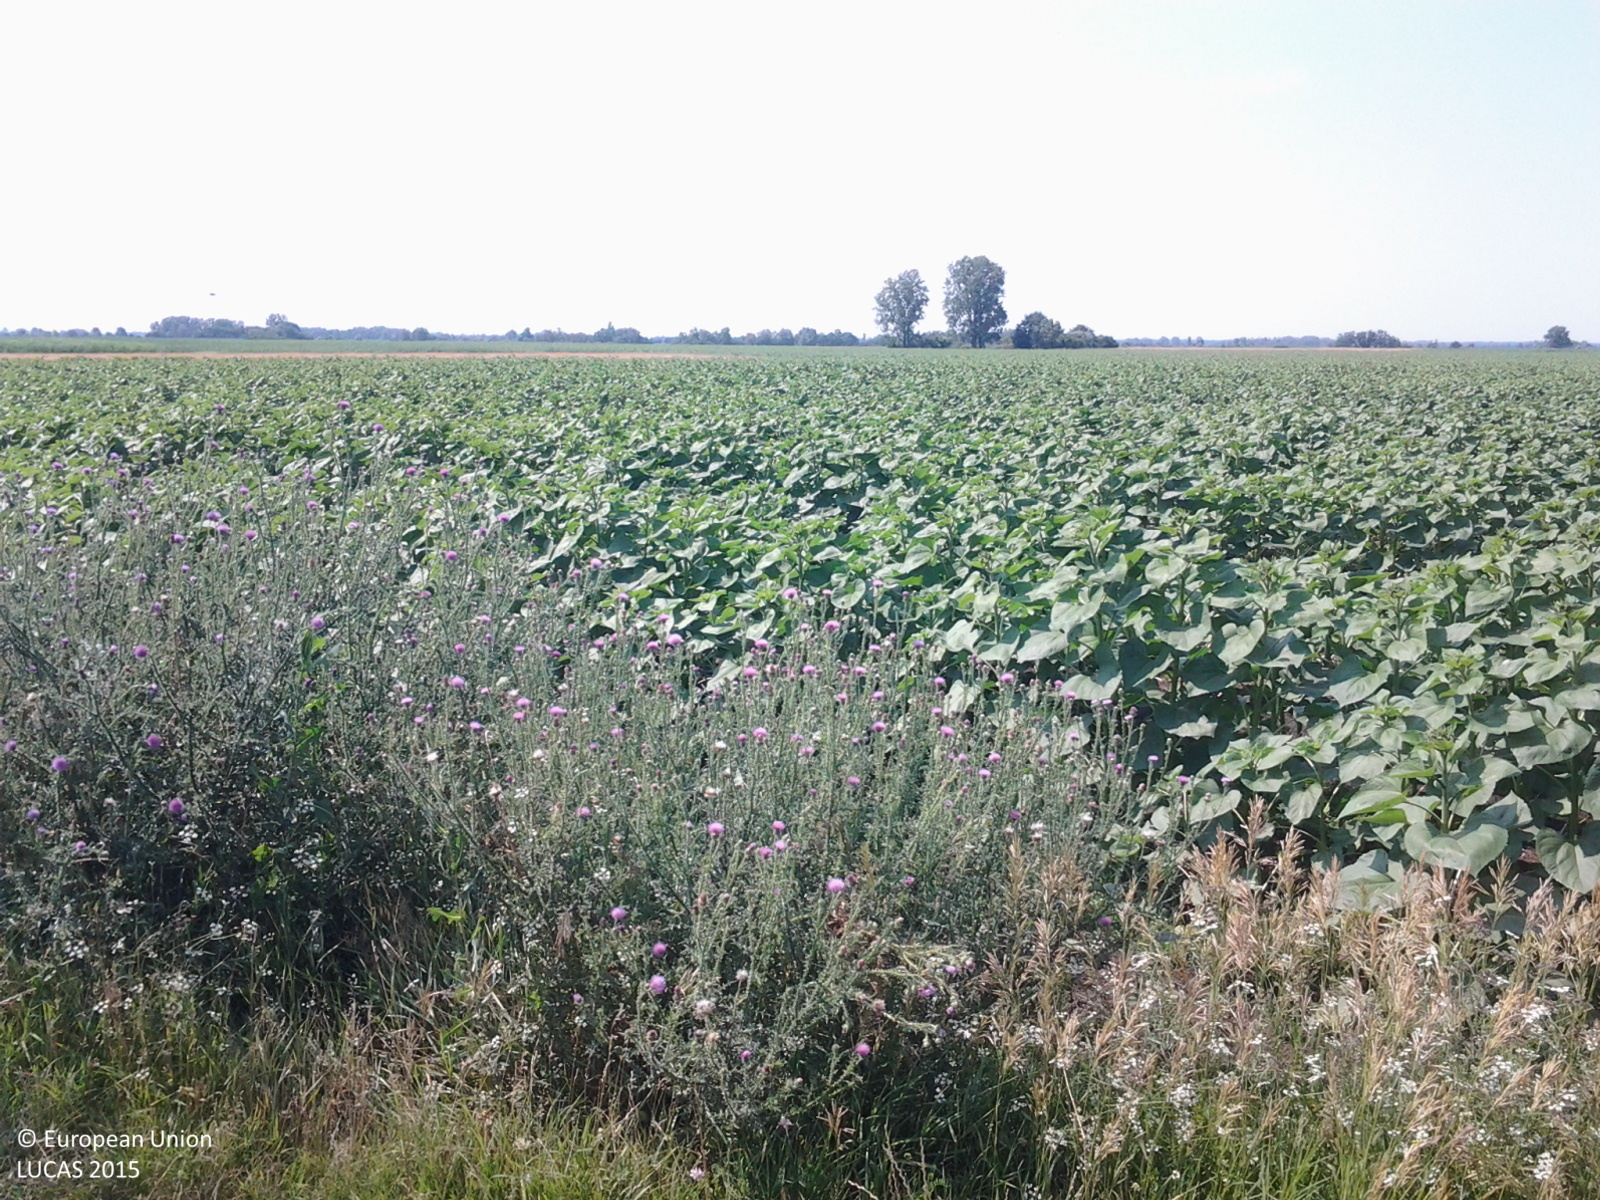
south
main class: Grassland
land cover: Grassland without tree/shrub cover
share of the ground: > 75 %
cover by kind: herbaceous plants 100 %
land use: Agriculture (excluding fallow land and kitchen gardens)
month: July
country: HU
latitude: 47.5593
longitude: 19.8999
